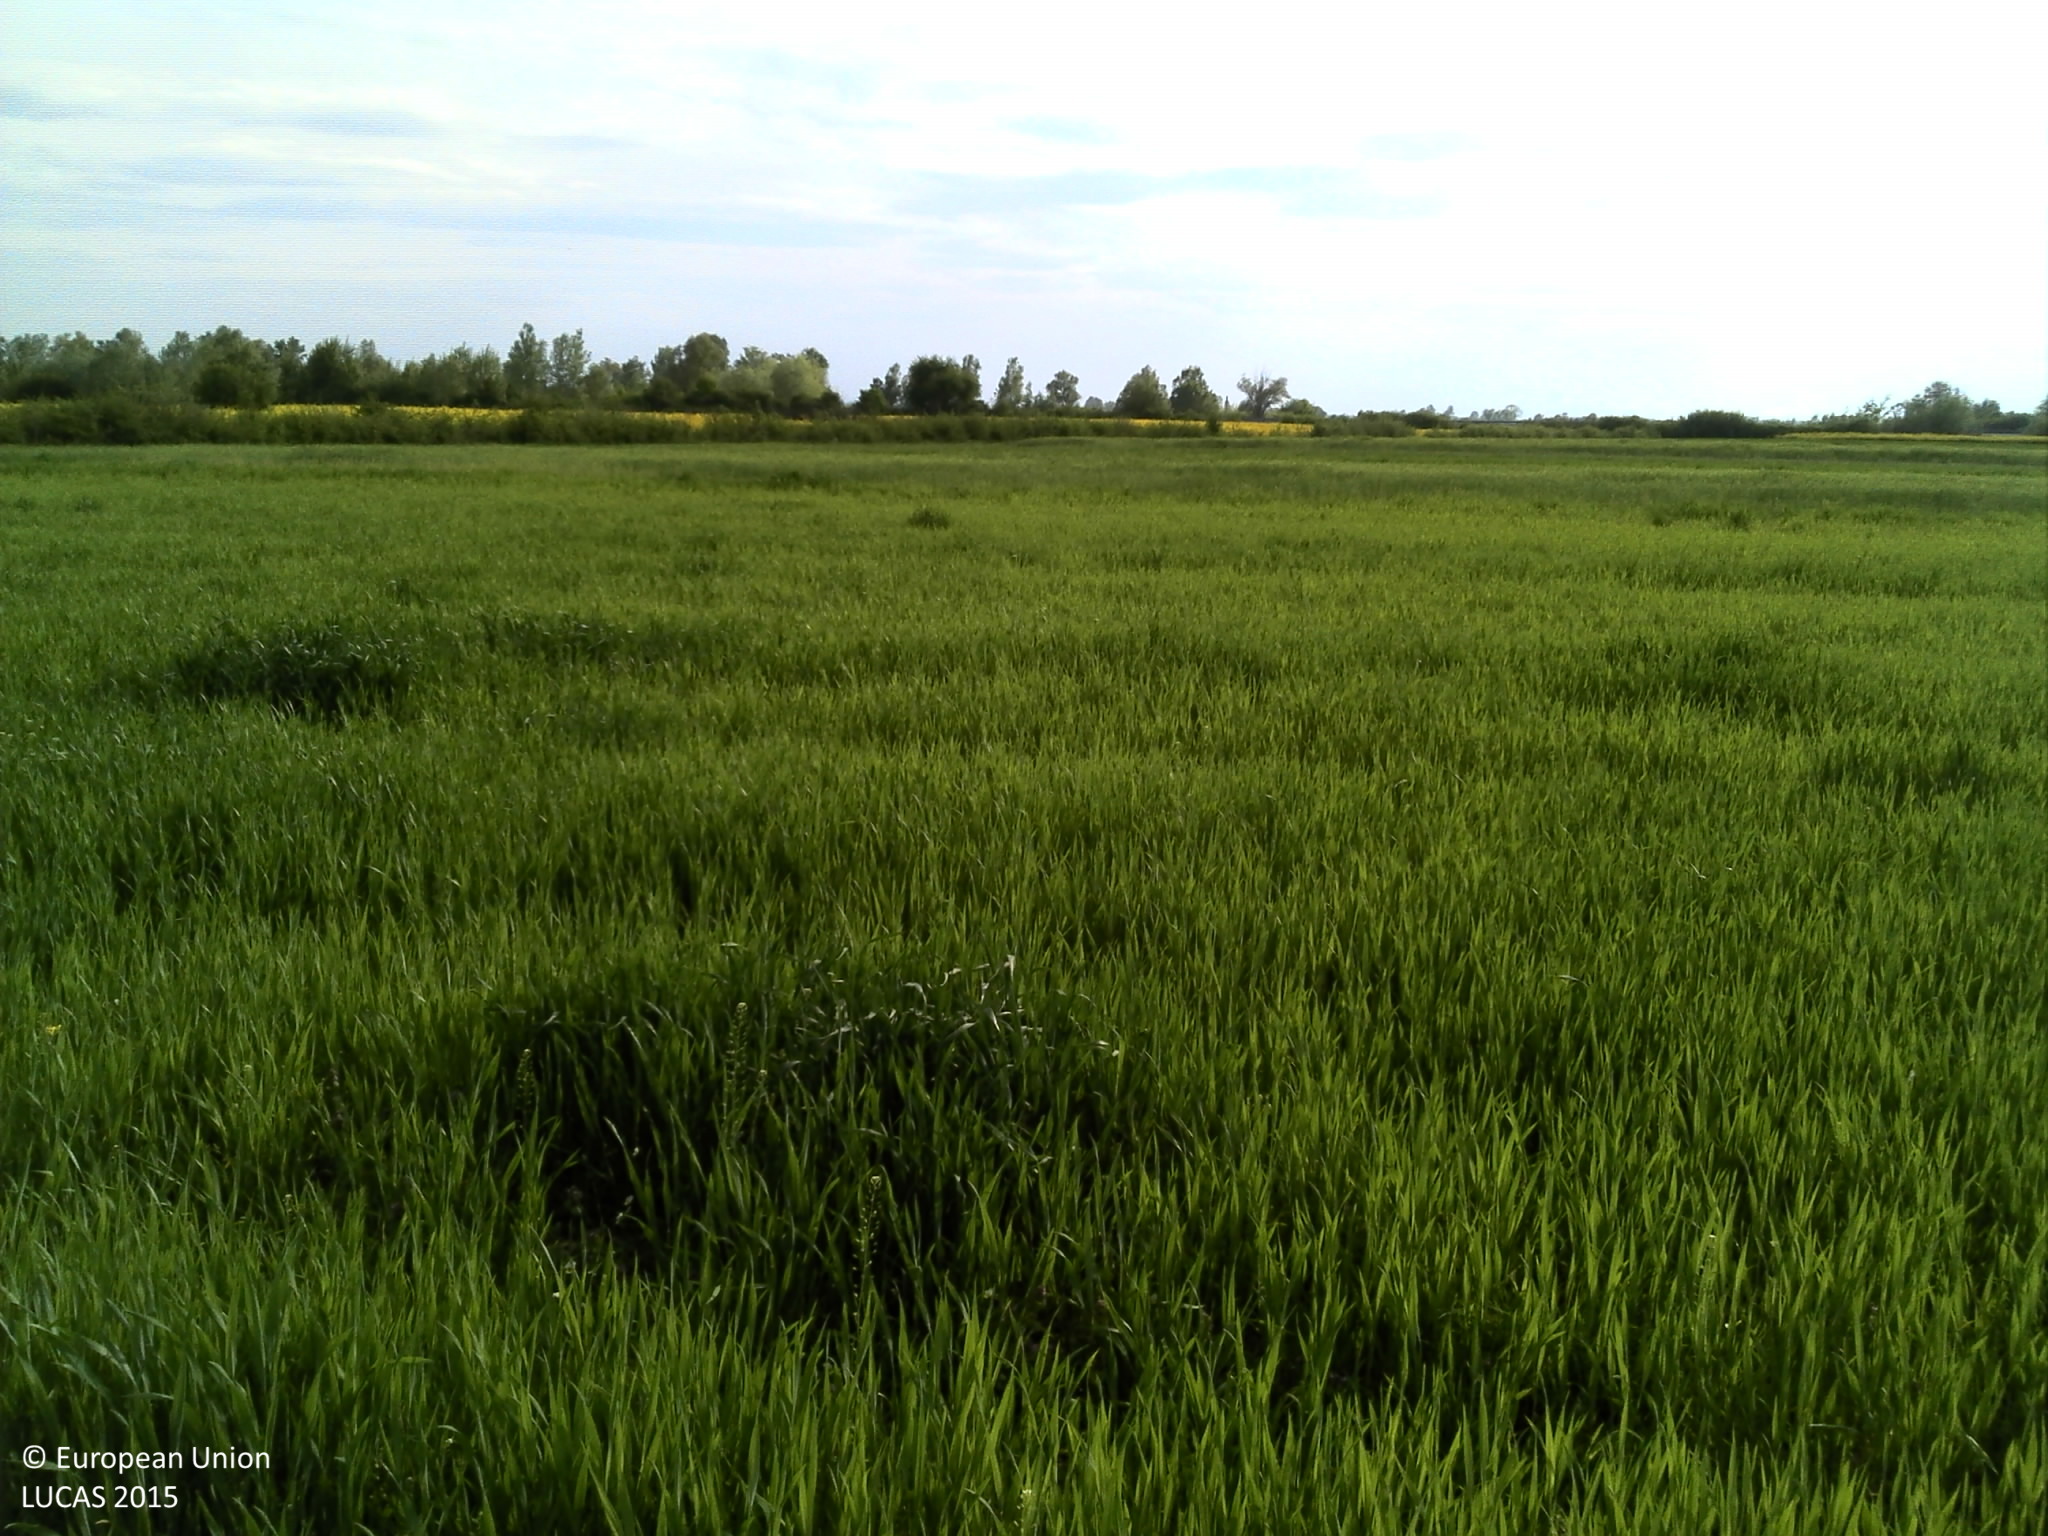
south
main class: Cropland
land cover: Common wheat
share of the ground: > 75 %
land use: Agriculture (excluding fallow land and kitchen gardens)
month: April
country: HR
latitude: 45.0633
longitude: 18.8072
